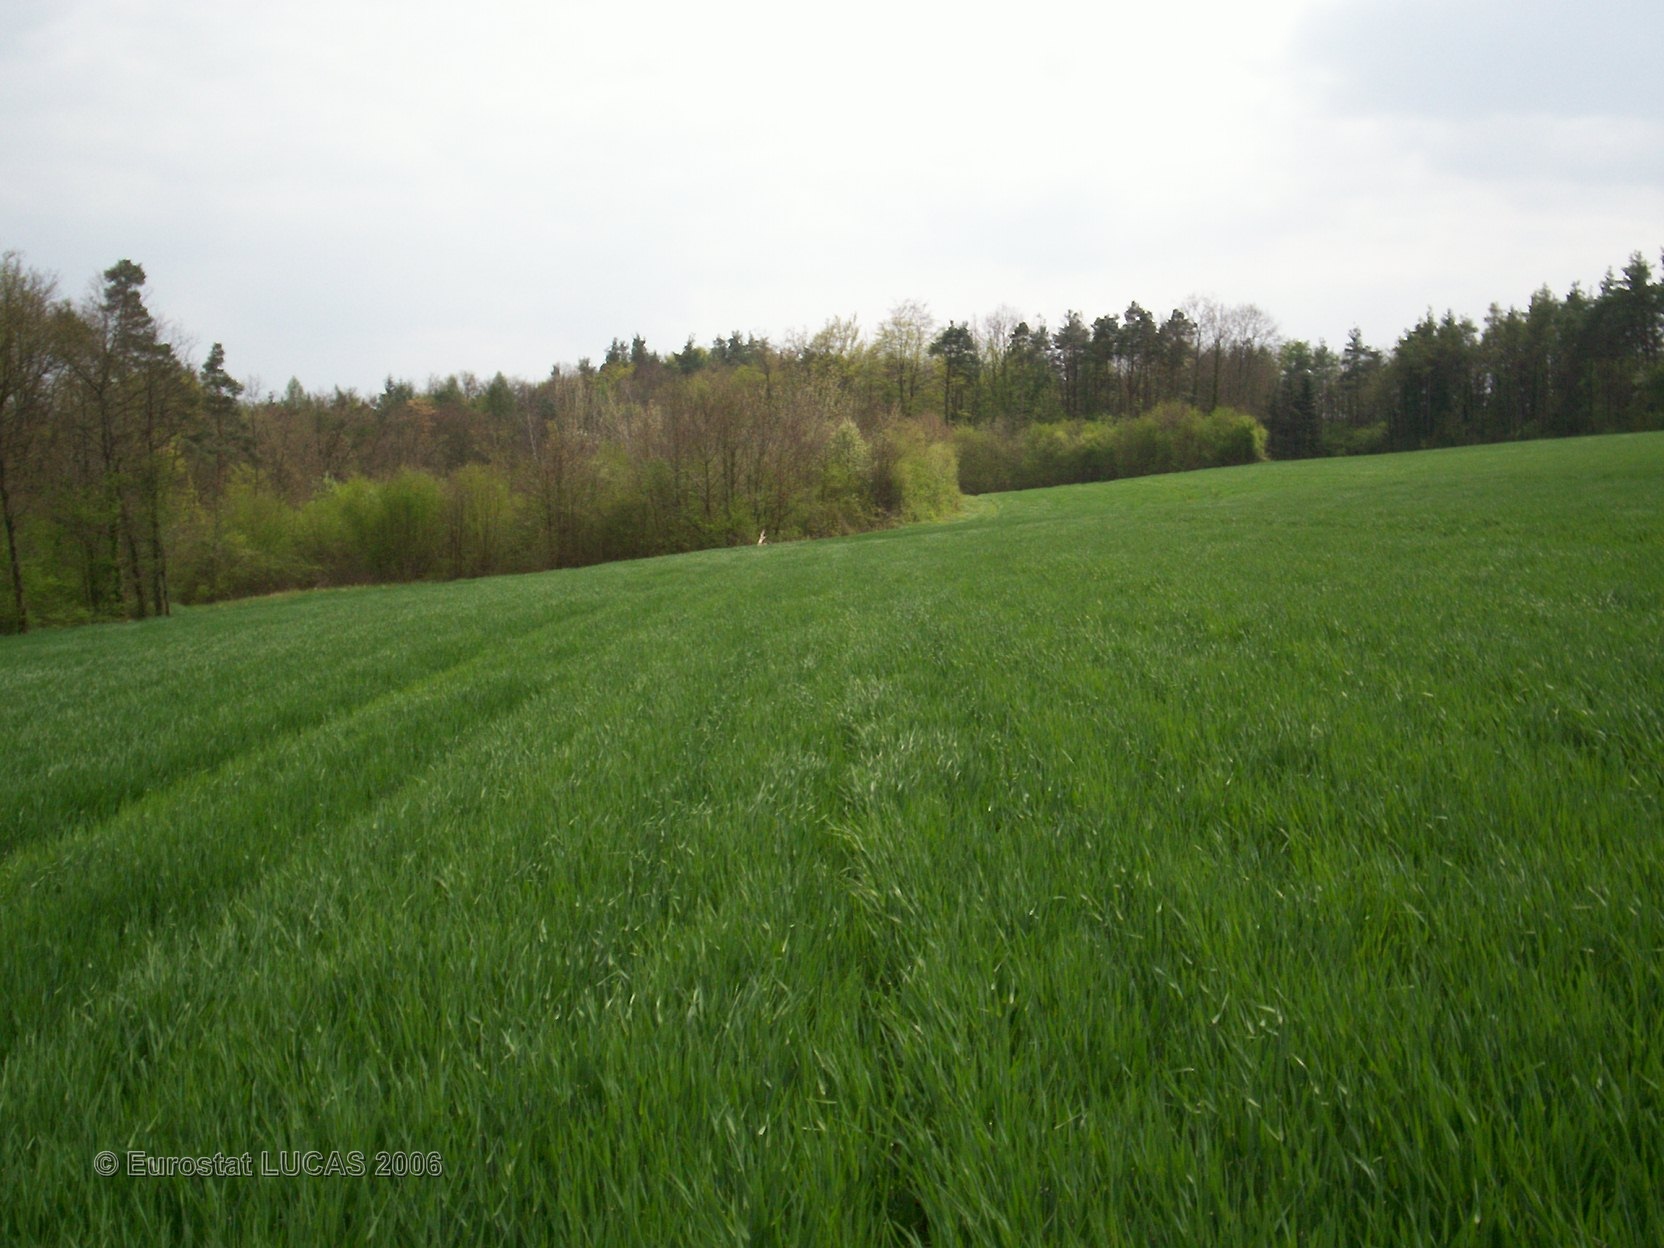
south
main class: Cropland
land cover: Barley
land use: Agriculture (excluding fallow land and kitchen gardens)
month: April
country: FR
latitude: 47.9418
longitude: 4.4959
